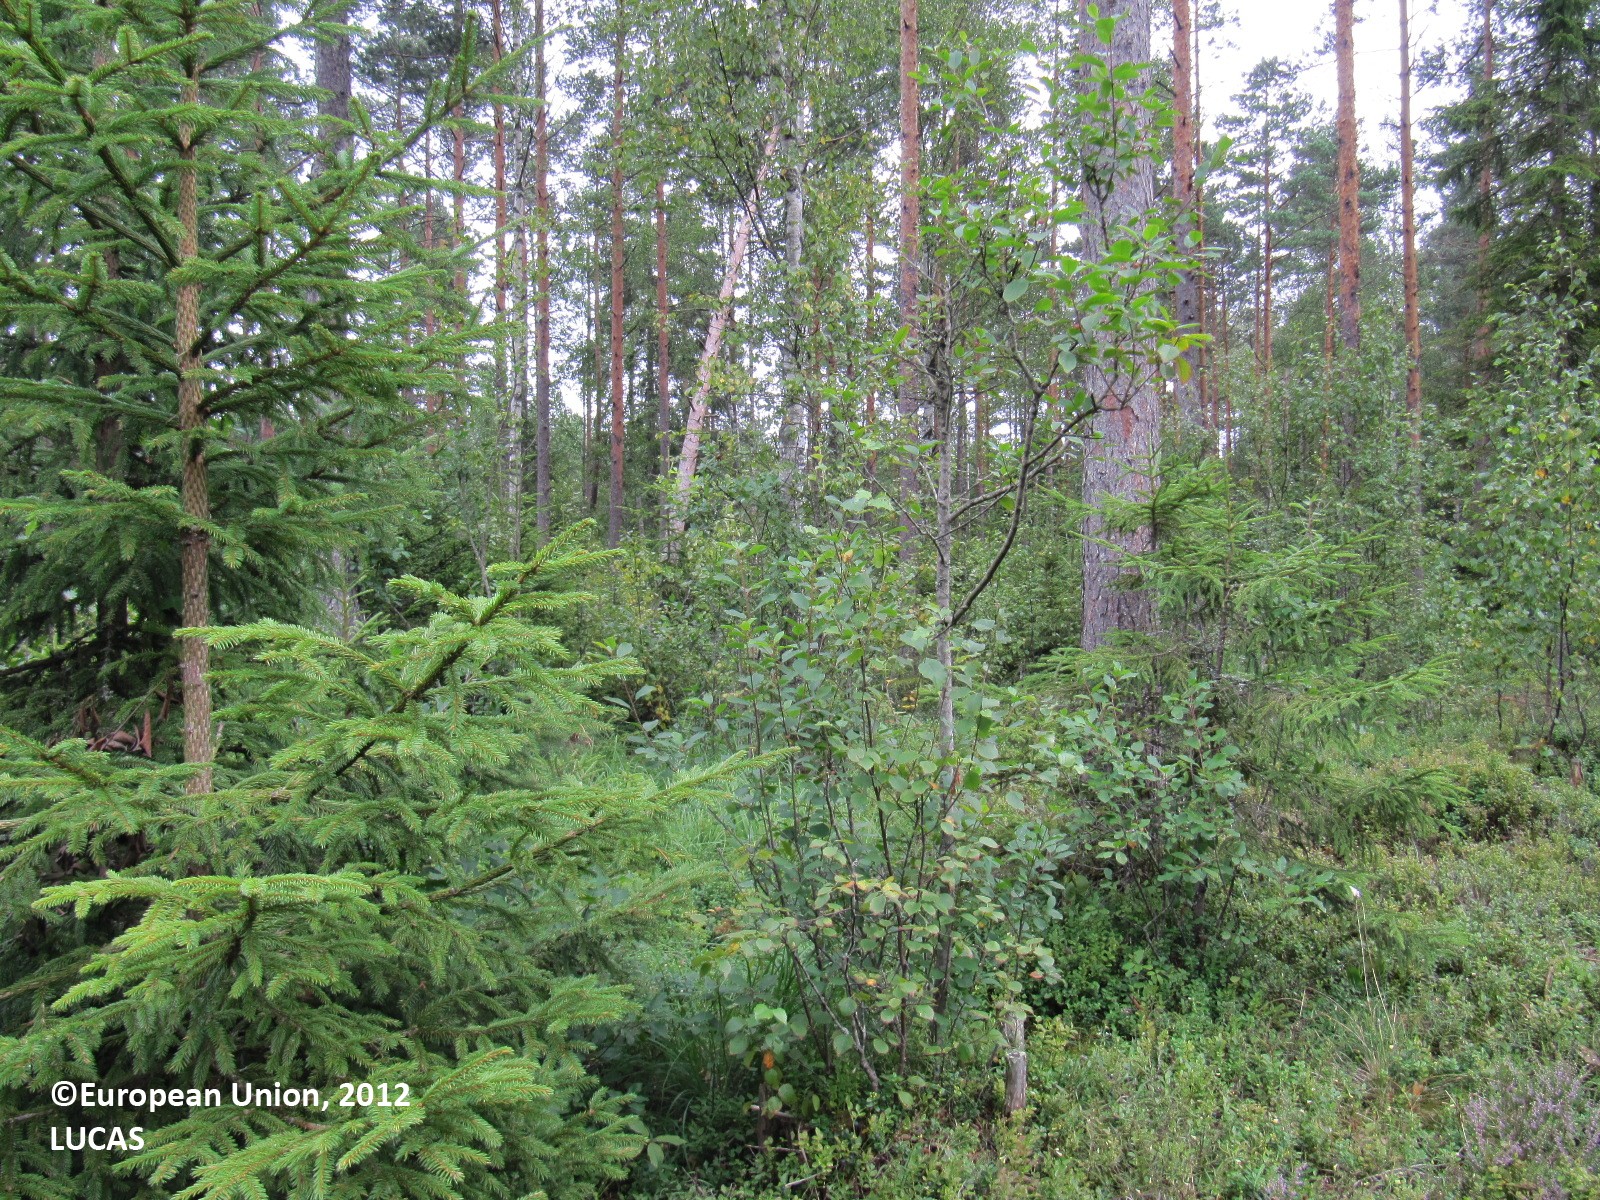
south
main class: Woodland
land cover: Pine dominated mixed woodland
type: boreal forest
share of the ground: > 75 %
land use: Forestry
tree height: > 5 m
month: August
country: FI
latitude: 60.2458
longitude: 23.0691
